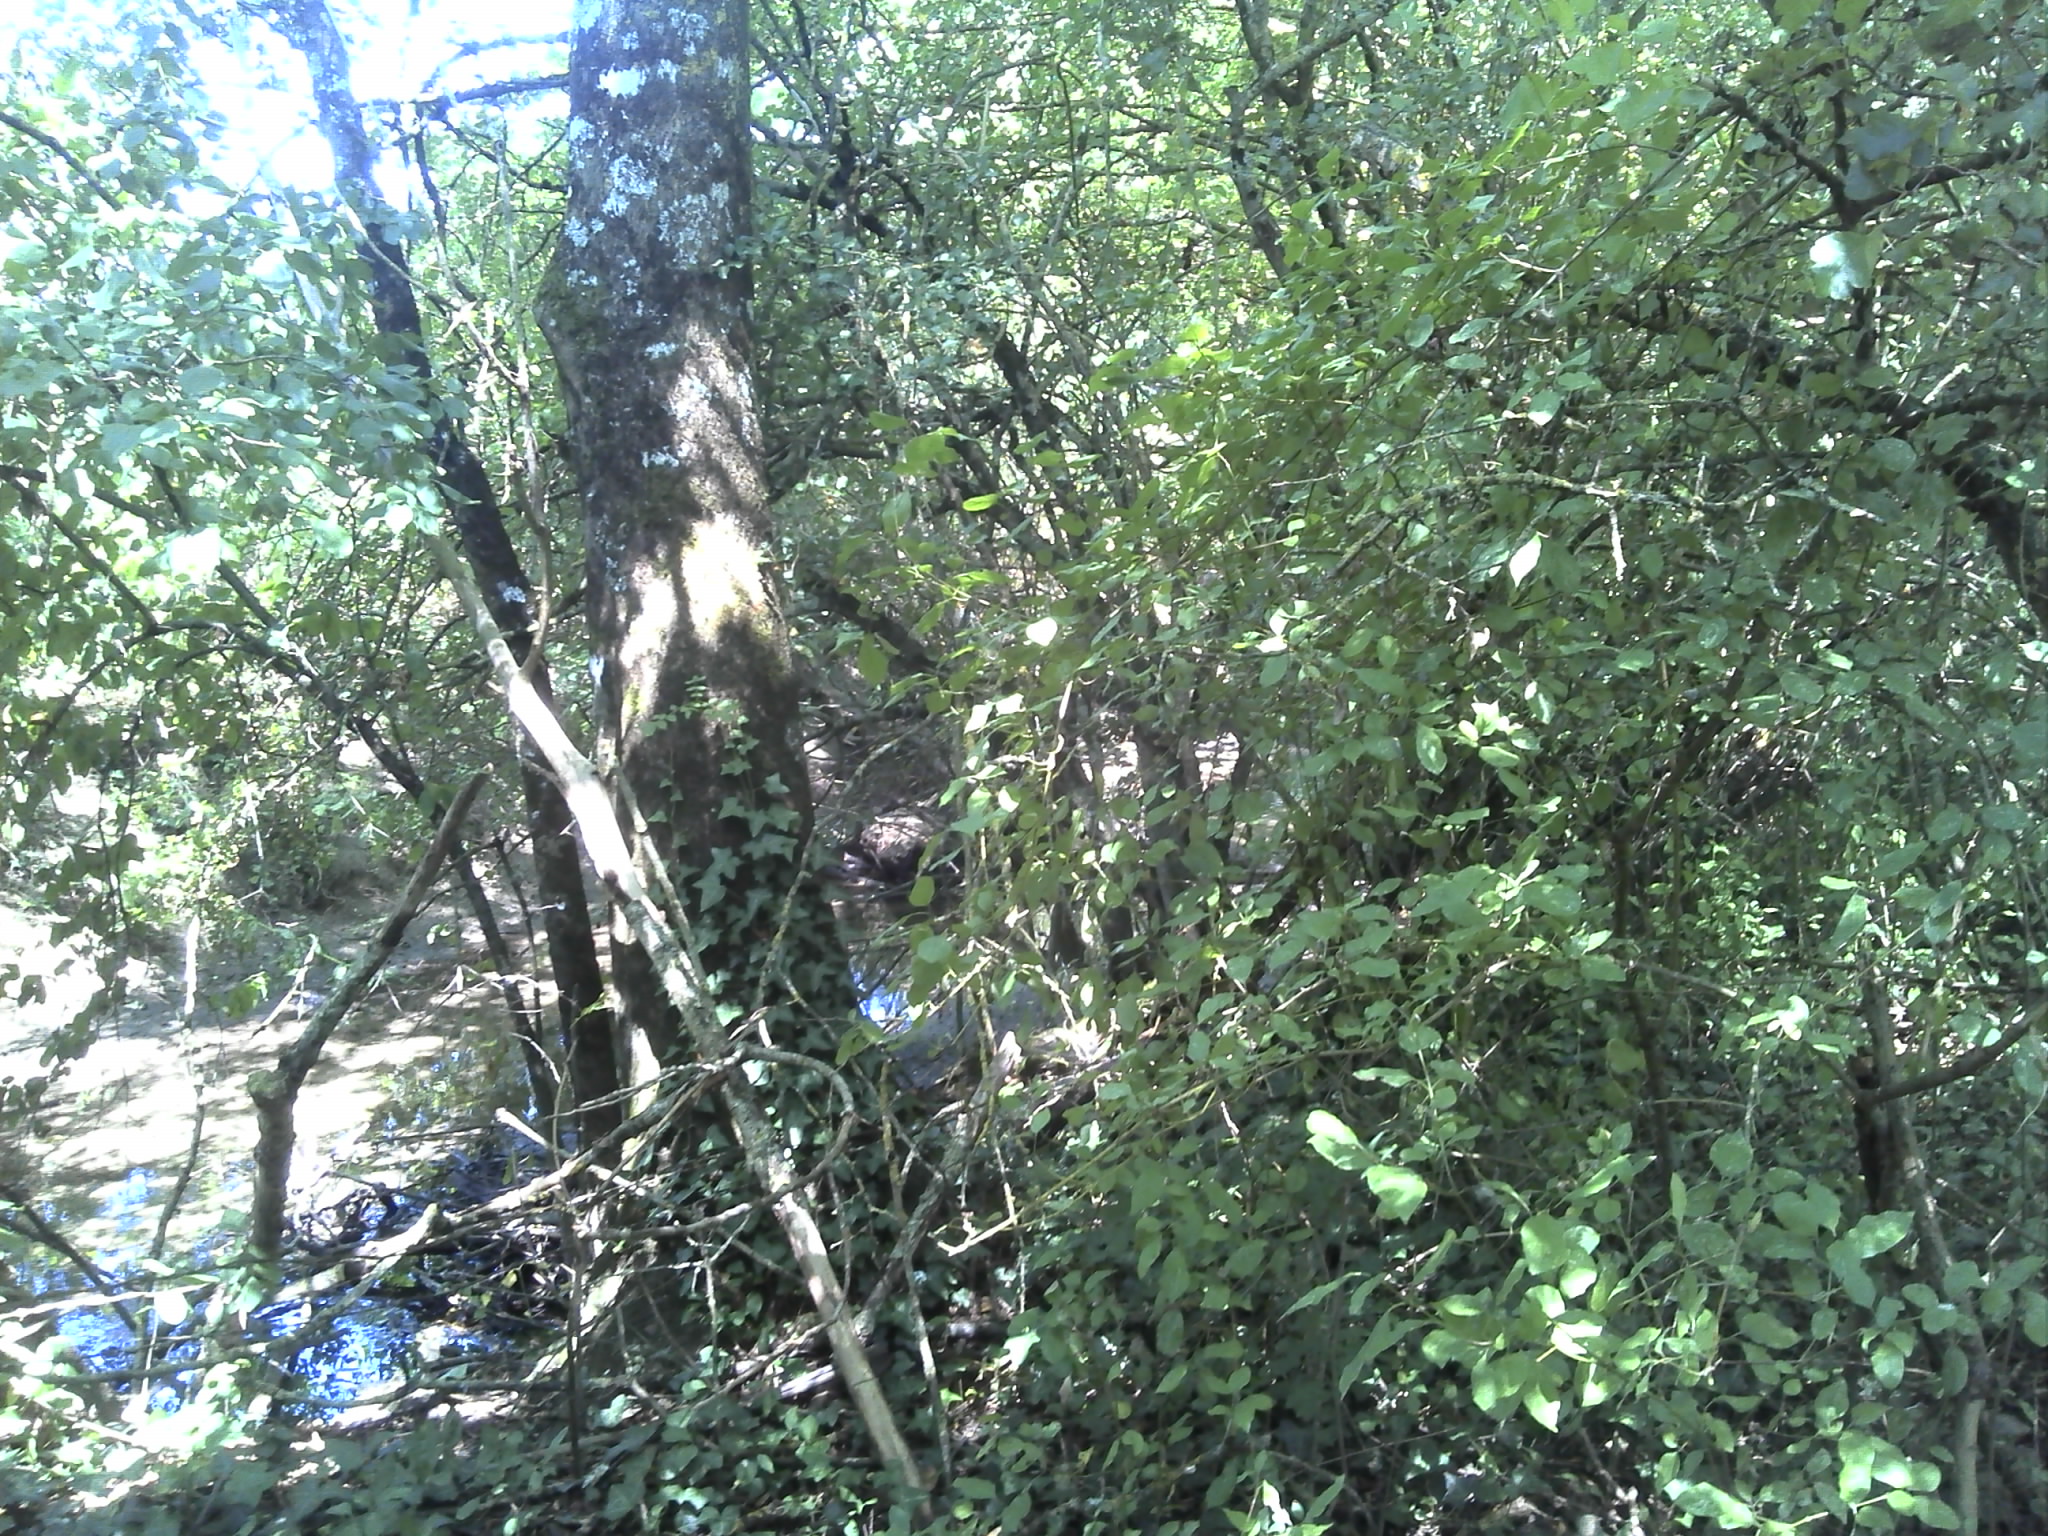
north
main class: Woodland
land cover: Broadleaved woodland
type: mesophytic deciduous forest
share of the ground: > 75 %
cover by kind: broadleaved forest trees 90 %, shrubs 10 %
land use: Agriculture (excluding fallow land and kitchen gardens)
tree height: > 5 m
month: August
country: FR
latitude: 46.8317
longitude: 1.5590
